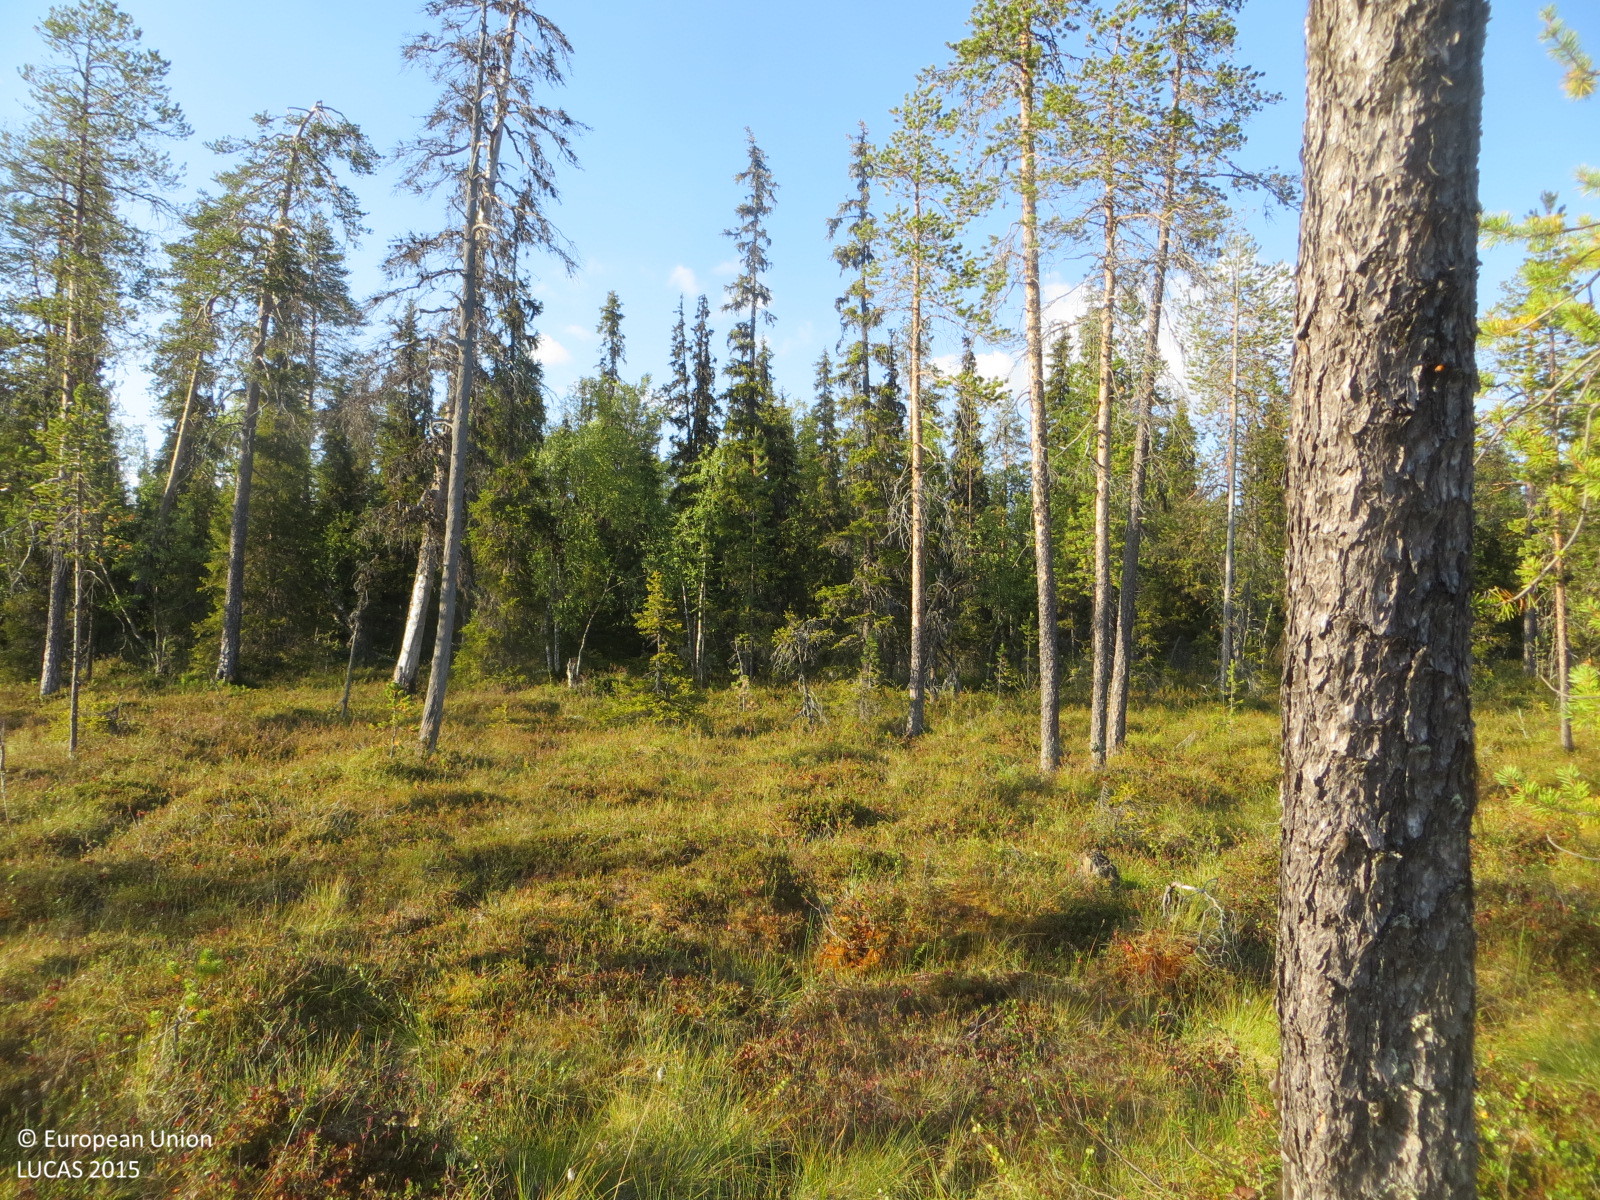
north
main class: Woodland
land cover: Pine dominated coniferous woodland
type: mire and swamp forests
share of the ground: 10 - 25 %
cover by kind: shrubs 60 %, coniferous forest trees 20 %, herbaceous plants 20 %
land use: Amenities, museums, leisure
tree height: > 5 m
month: August
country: FI
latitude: 67.7876
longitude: 24.3169
